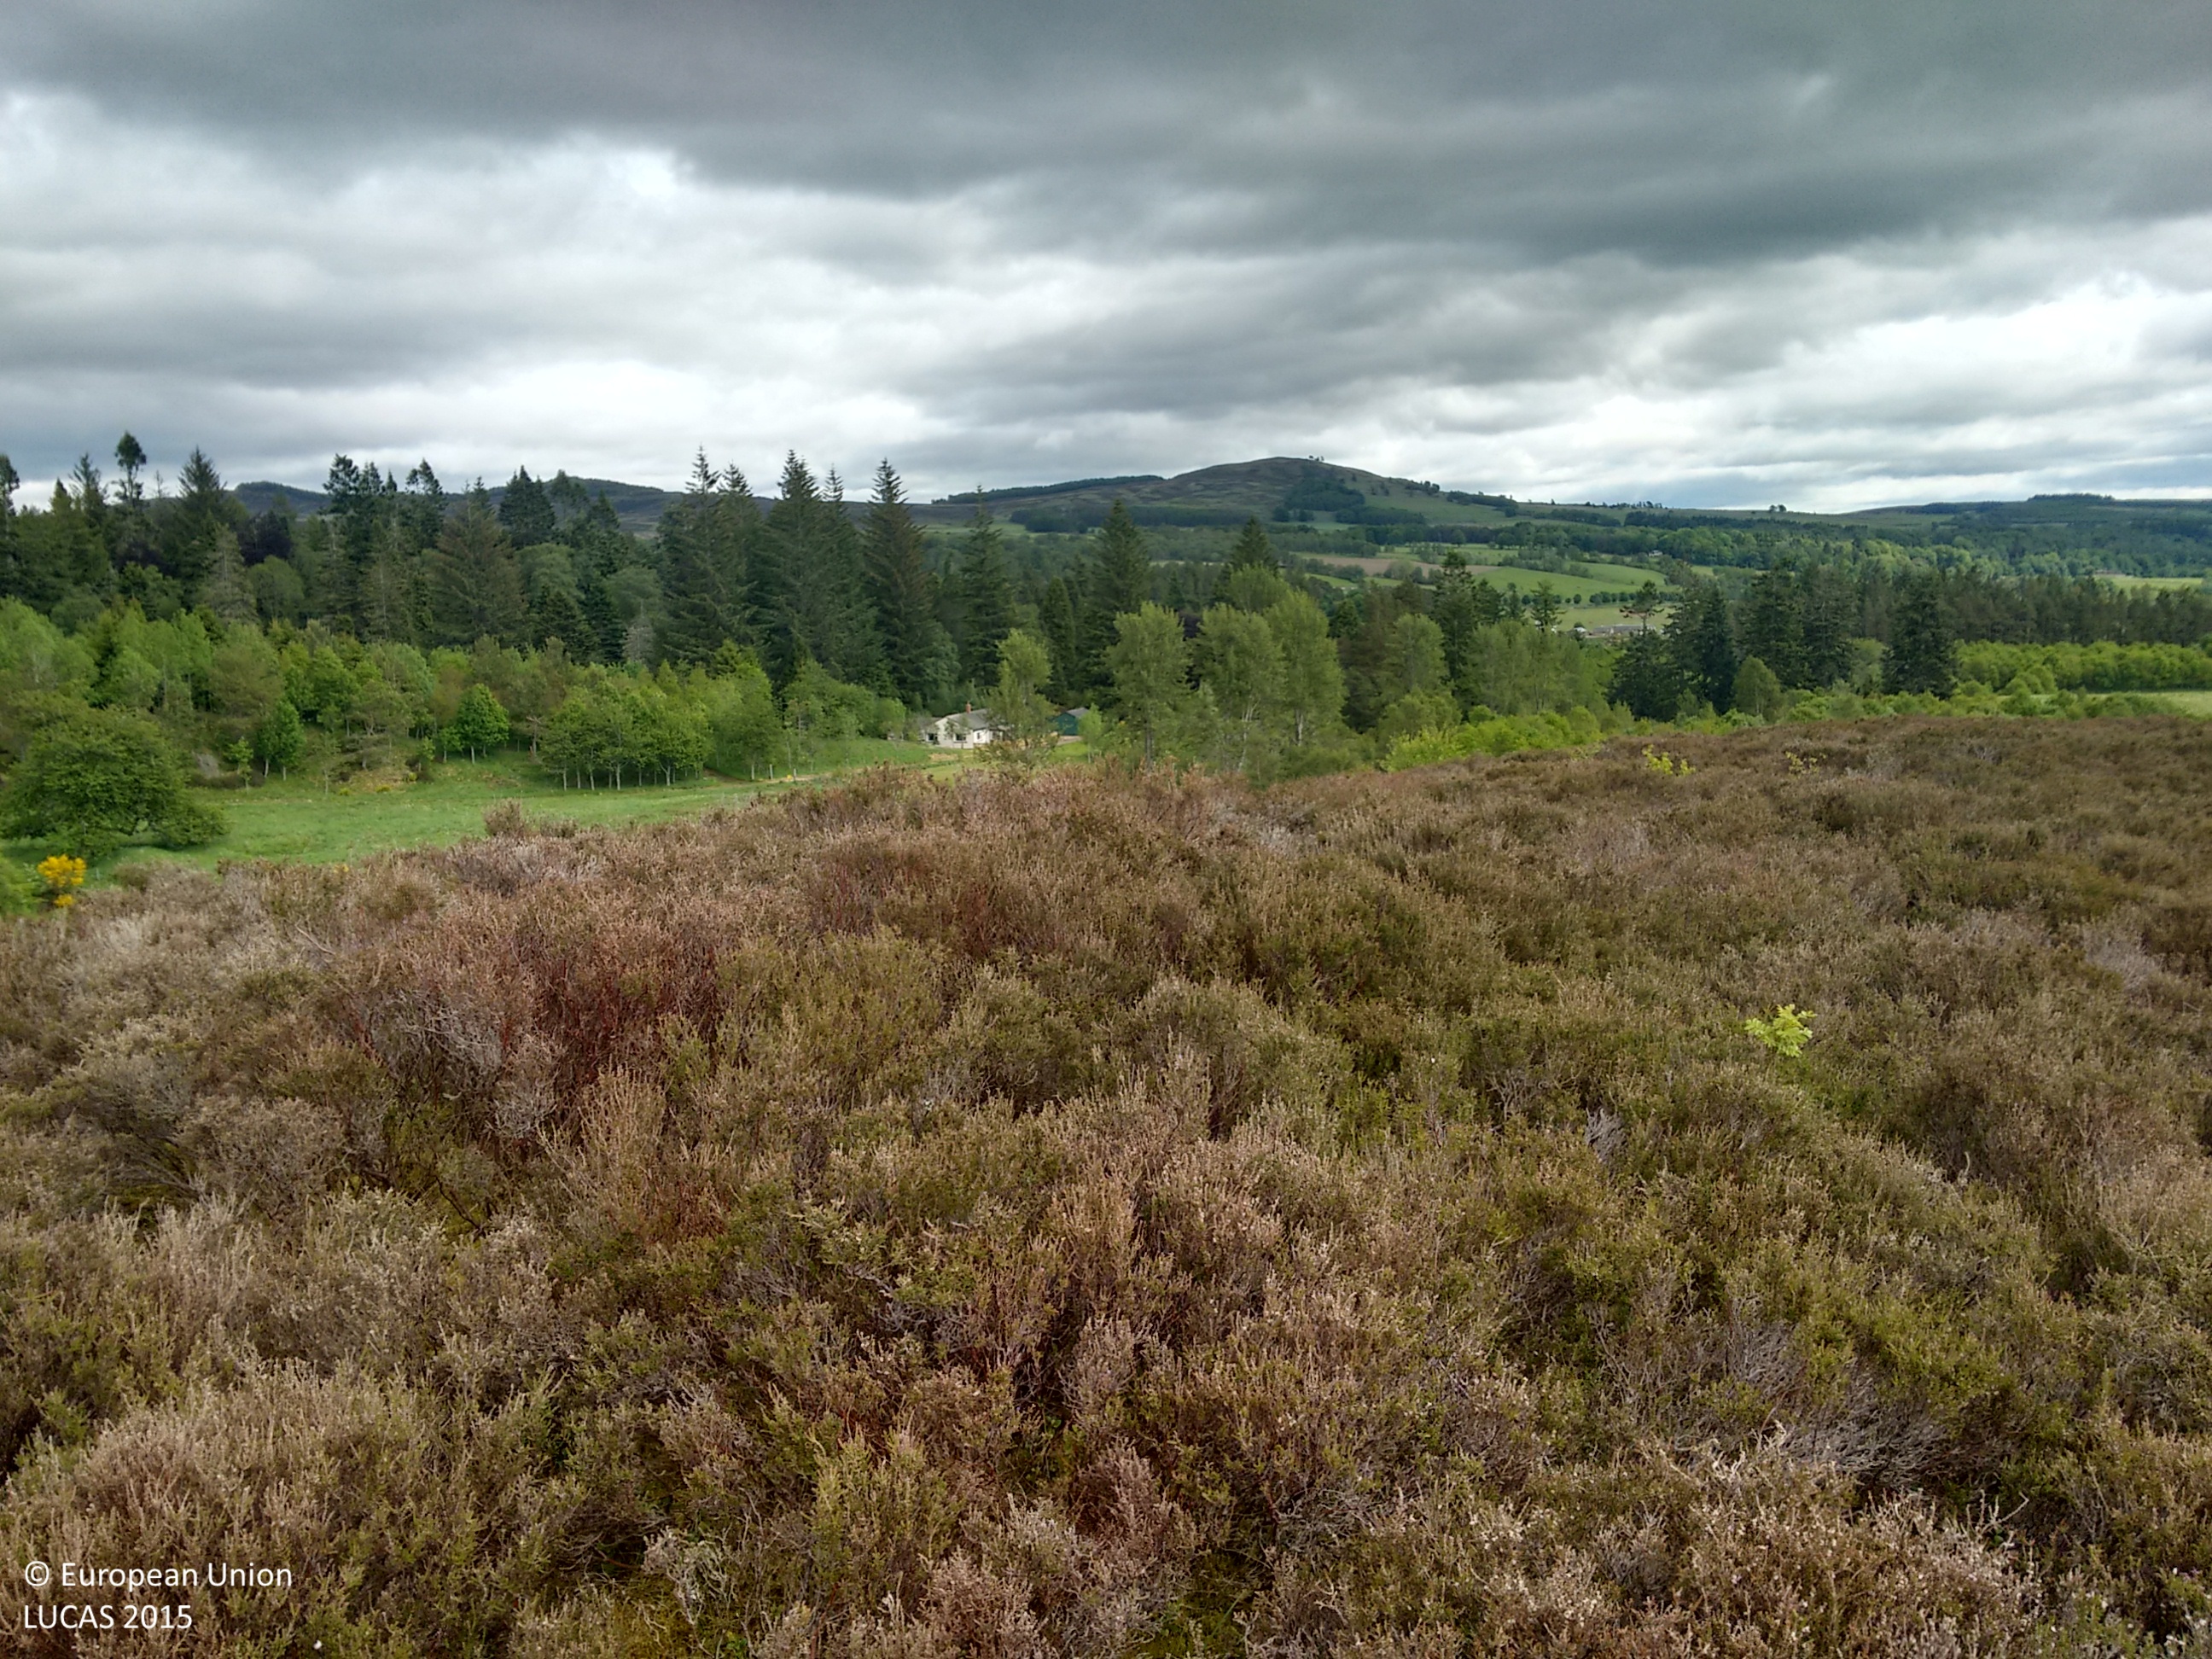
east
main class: Shrubland
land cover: Shrubland without tree cover
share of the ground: > 75 %
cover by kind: shrubs 95 %, herbaceous plants 5 %
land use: Agriculture (excluding fallow land and kitchen gardens)
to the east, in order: Shrubland without tree cover
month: June
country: GB
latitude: 56.6922
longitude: -3.5125
